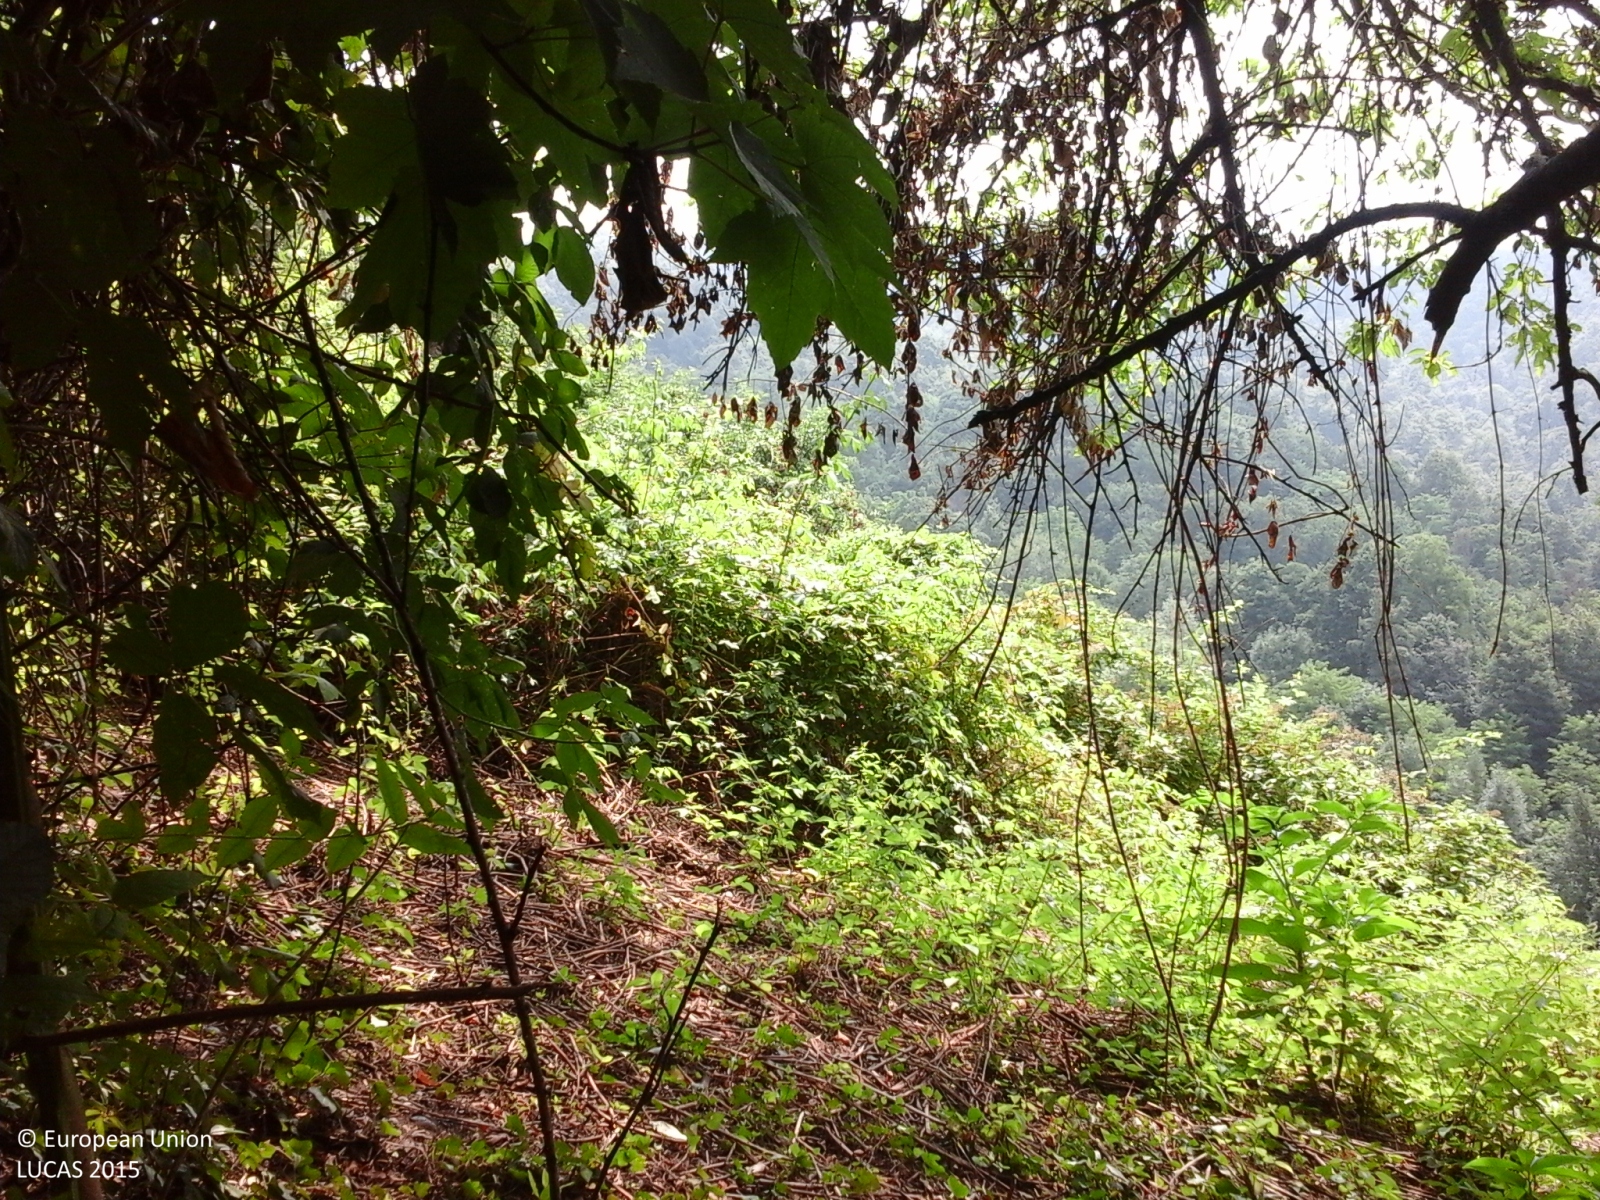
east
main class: Woodland
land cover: Broadleaved woodland
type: thermophilous deciduous forest
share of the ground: > 75 %
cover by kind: broadleaved forest trees 100 %
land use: Semi-natural and natural areas not in use
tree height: > 5 m
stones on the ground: 10 - 25 %
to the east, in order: Broadleaved woodland; Shrubland without tree cover; Tracks; Abandoned hedges; Artificial constructions; Fences; Grass margins; Vineyards; Grassland without tree/shrub cover; Other fresh vegetables; Fences; Broadleaved woodland; Paved roads, cycling and walking lanes; Artificial constructions; Electric lines; Grassland with sparse tree/shrub cover
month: July
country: IT
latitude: 45.0839
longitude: 7.7553
